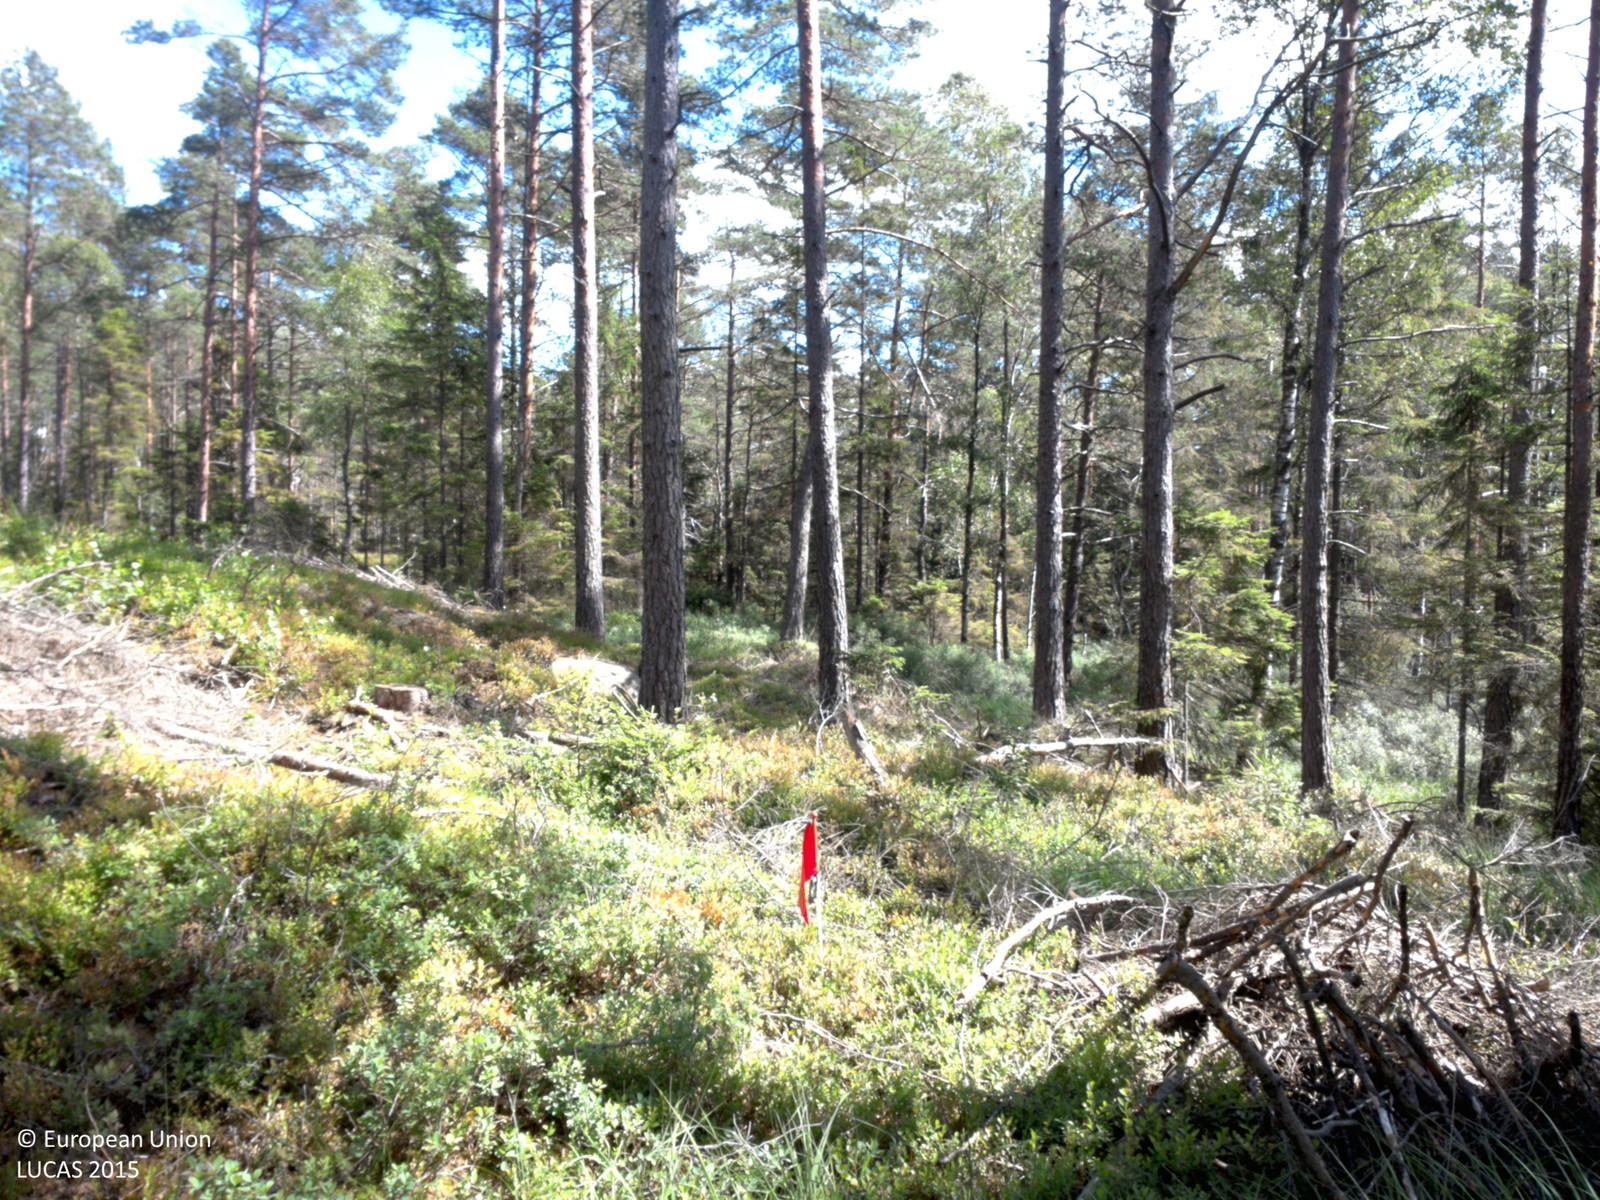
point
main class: Woodland
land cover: Pine dominated coniferous woodland
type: boreal forest
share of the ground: 50 - 75 %
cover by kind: coniferous forest trees 45 %, shrubs 25 %, lichens and mosses 25 %, broadleaved forest trees 5 %
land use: Forestry
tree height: > 5 m
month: July
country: SE
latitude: 58.5672
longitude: 11.8013
